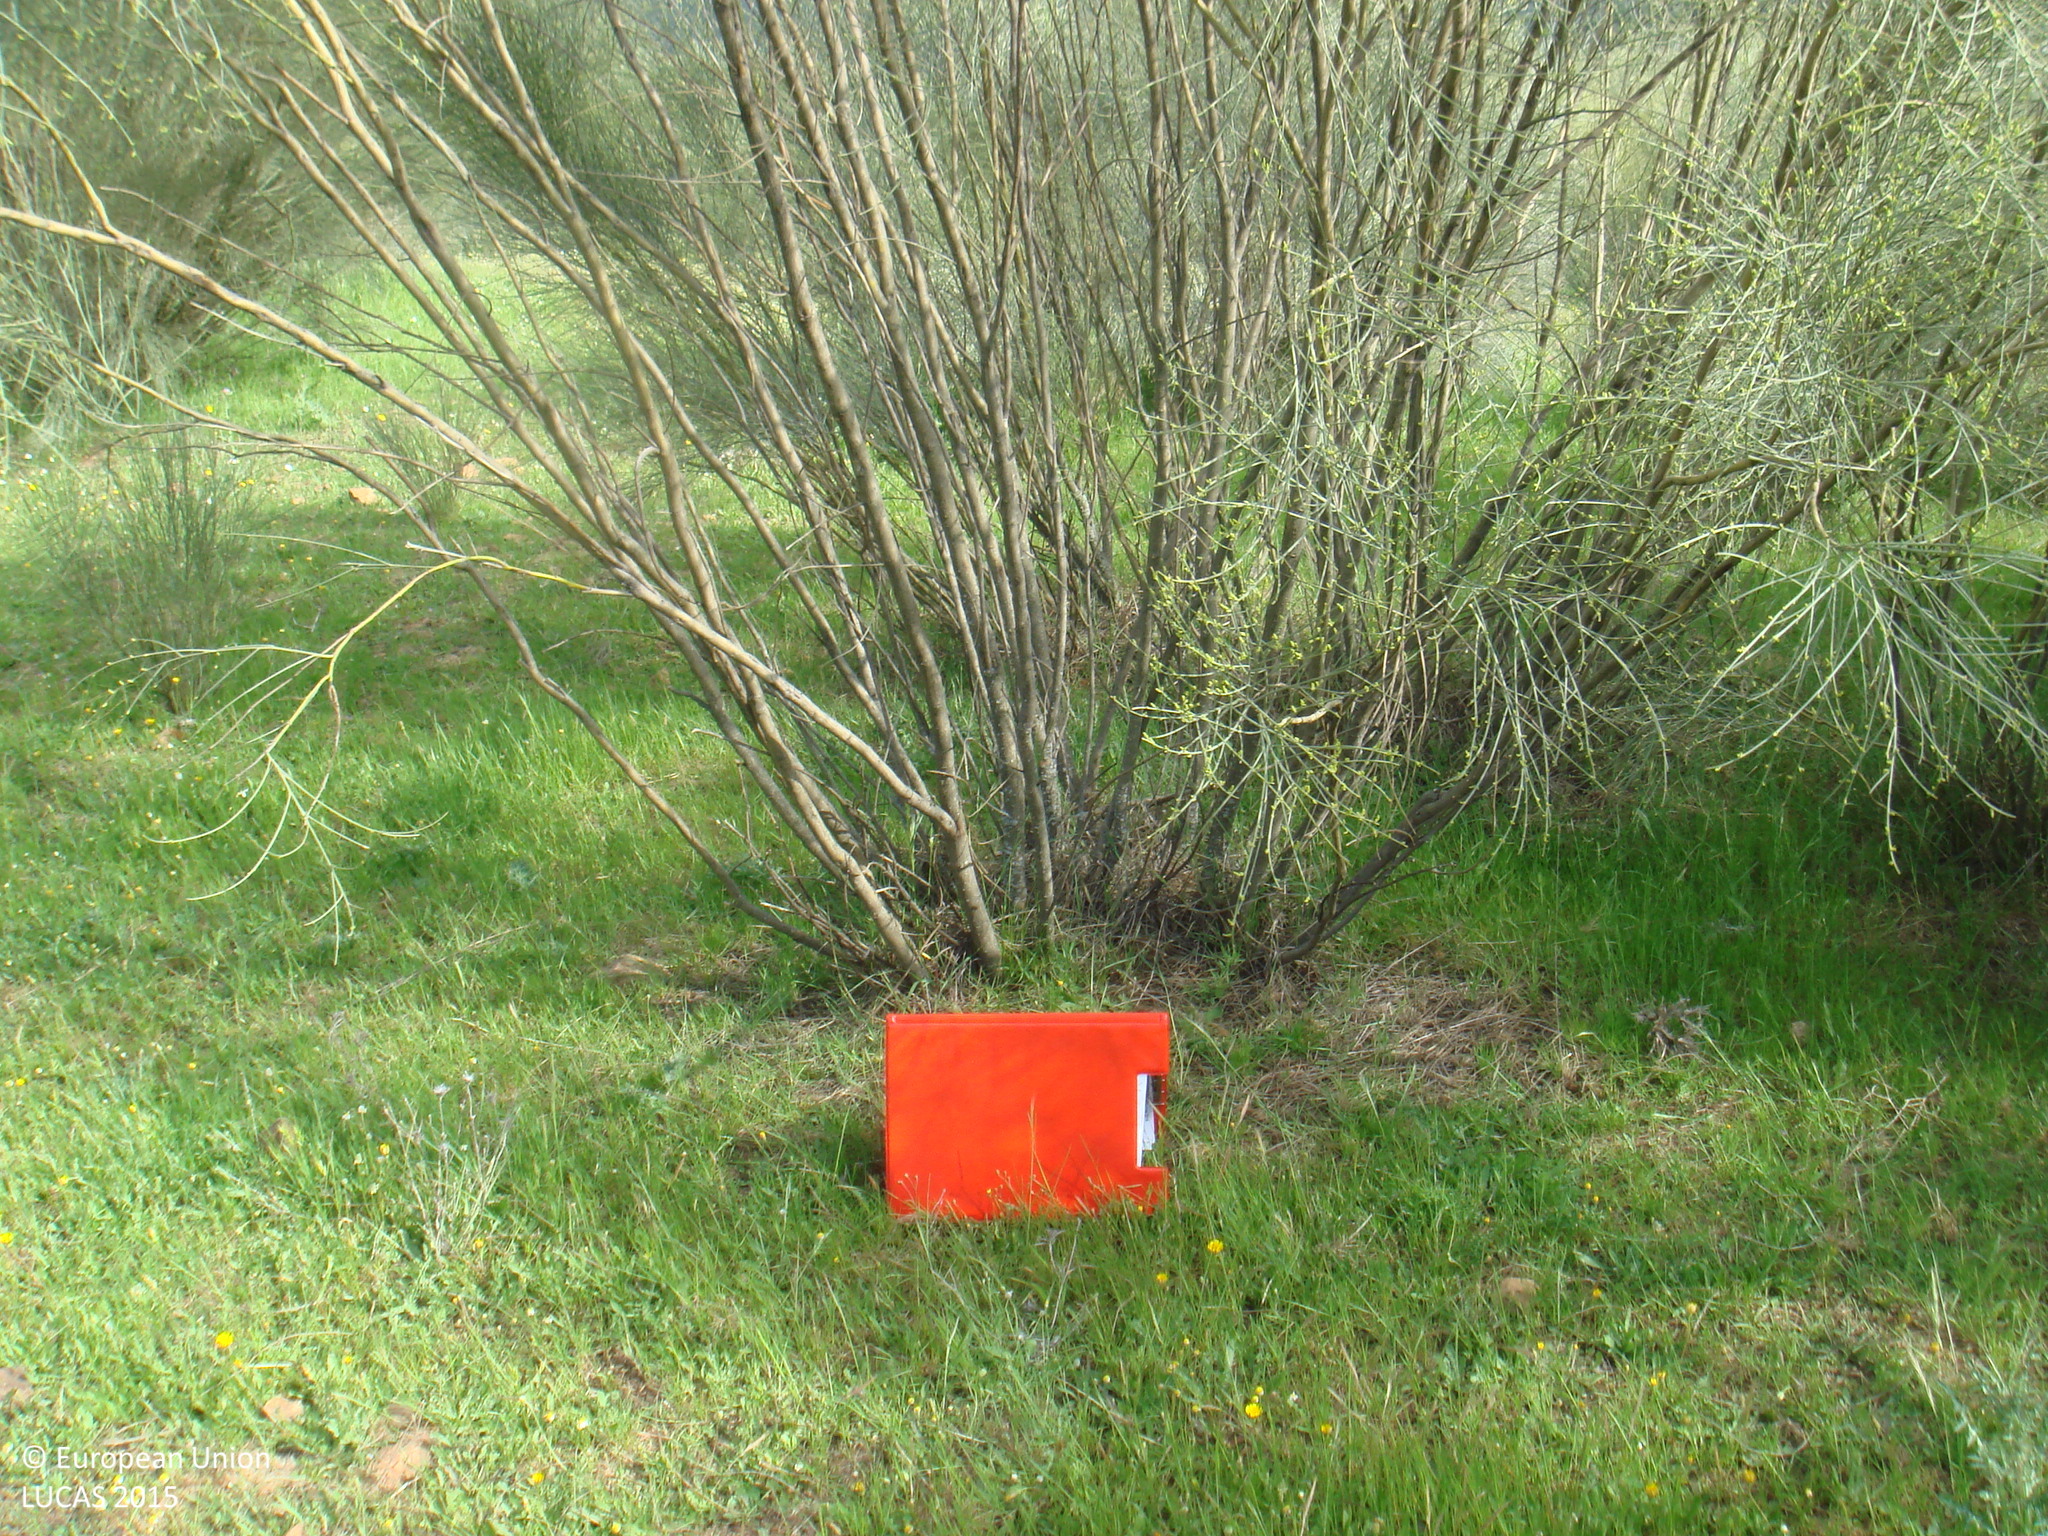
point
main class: Shrubland
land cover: Shrubland without tree cover
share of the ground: 25 - 50 %
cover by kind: herbaceous plants 70 %, shrubs 30 %
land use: Agriculture (excluding fallow land and kitchen gardens)
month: April
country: ES
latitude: 38.2174
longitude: -5.2752
